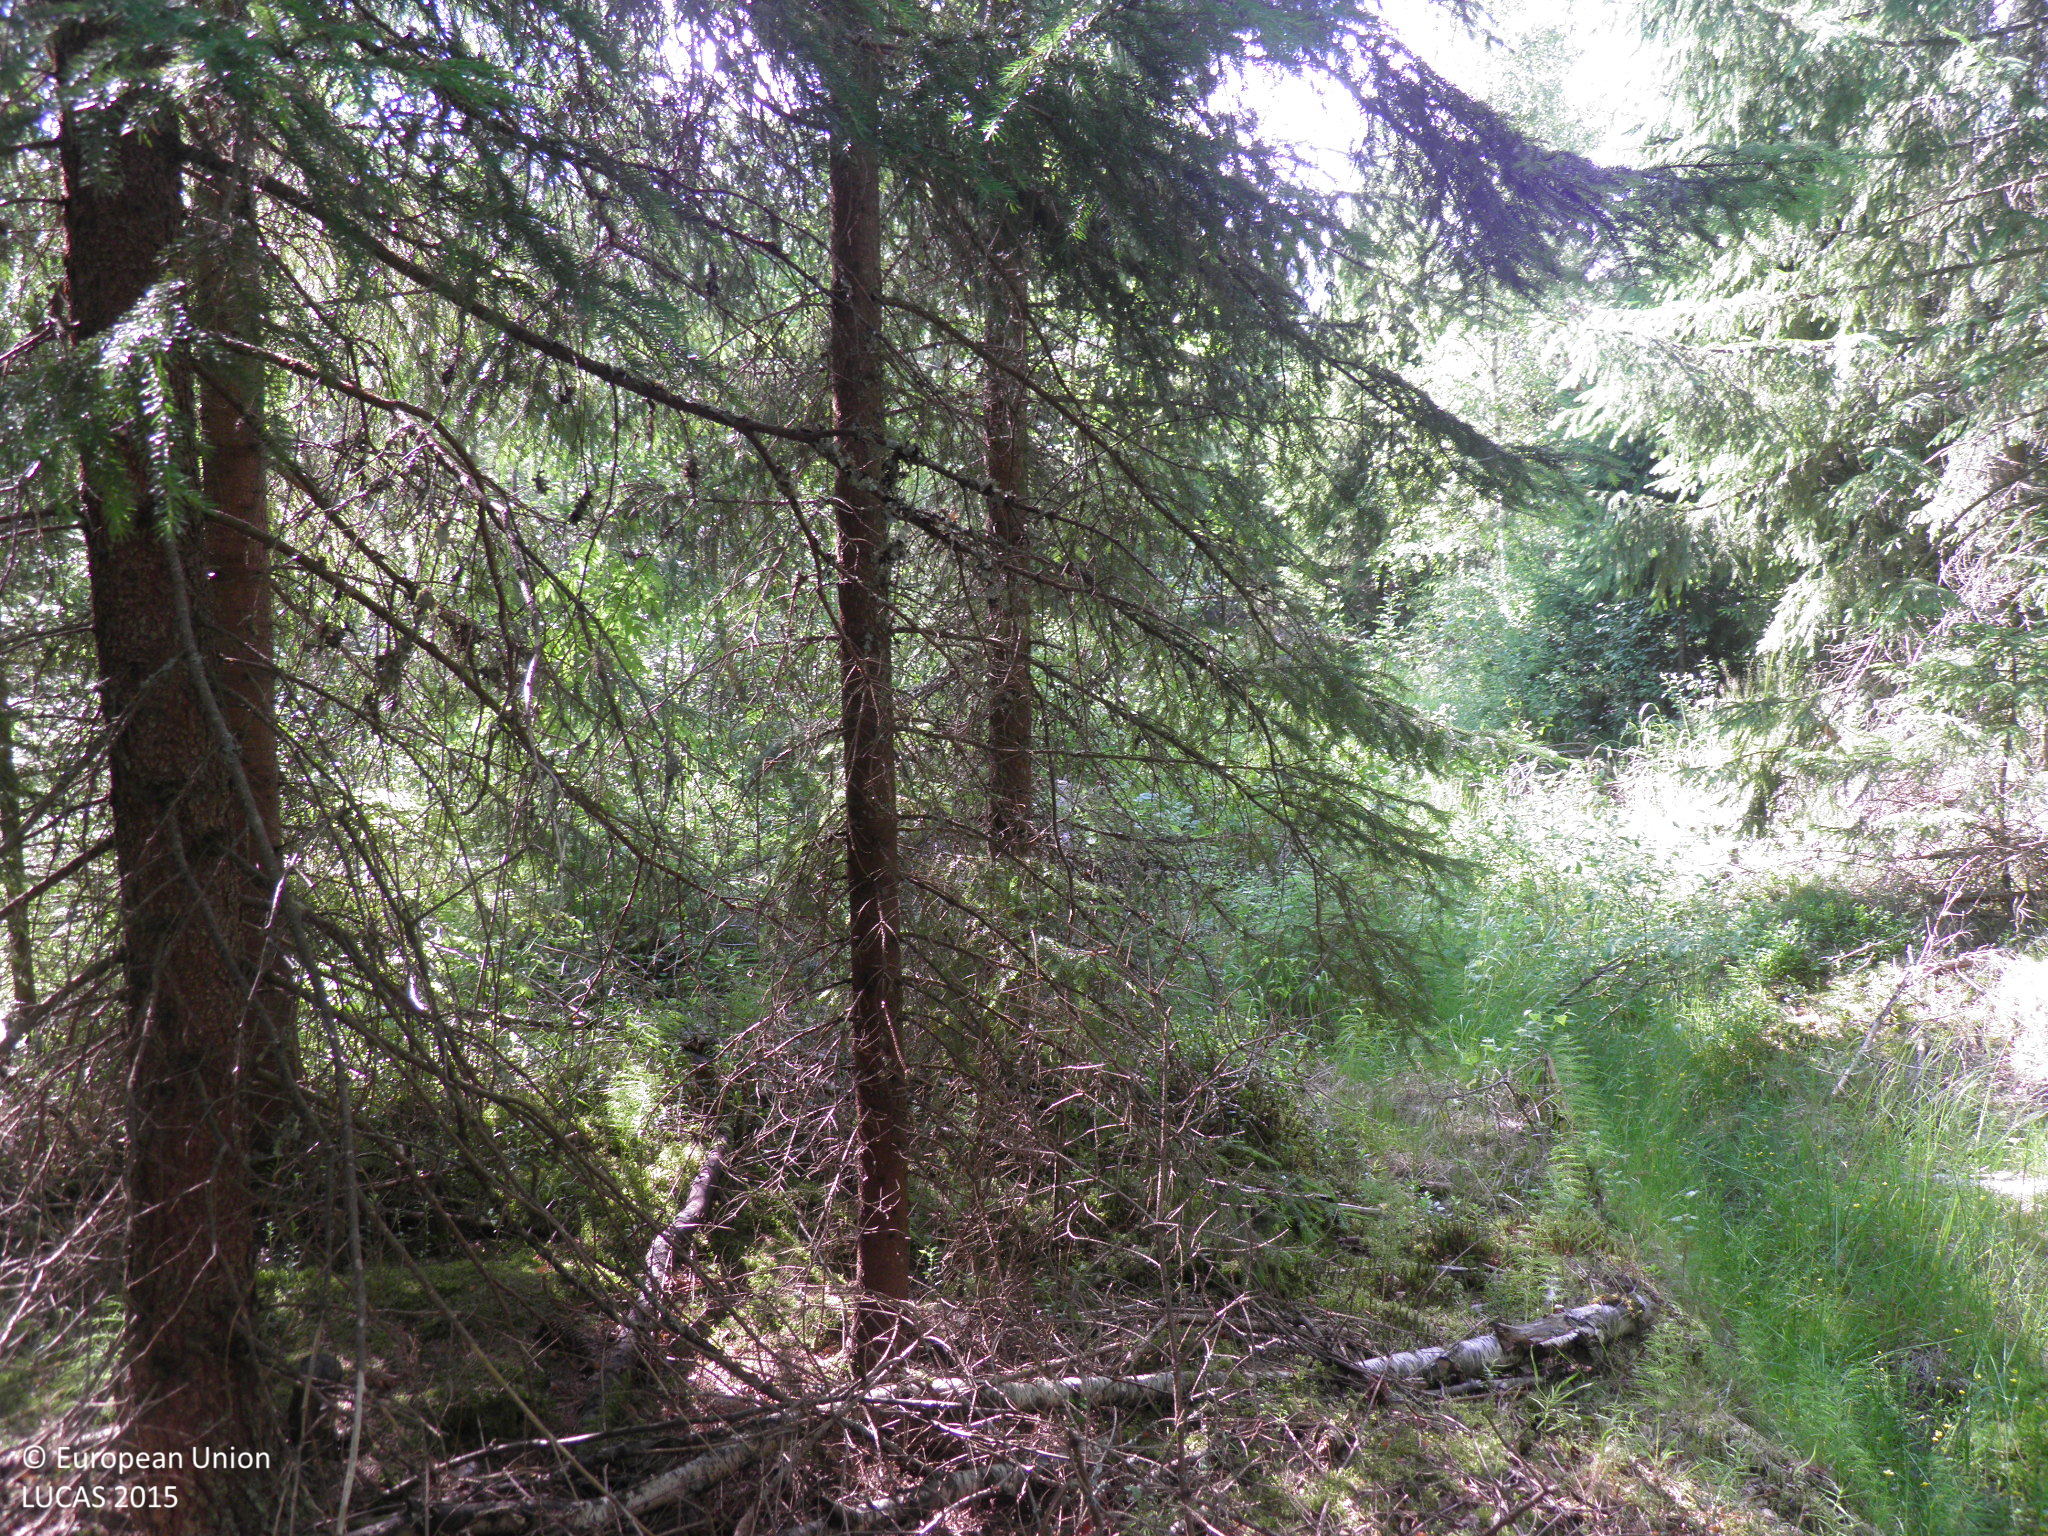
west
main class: Woodland
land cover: Spruce dominated mixed woodland
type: hemiboreal forest and nemoral coniferous forest and mixed broadleaved-coniferous forest
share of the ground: 50 - 75 %
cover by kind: coniferous forest trees 40 %, broadleaved forest trees 30 %, shrubs 10 %, herbaceous plants 10 %, lichens and mosses 10 %
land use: Forestry
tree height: > 5 m
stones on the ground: < 10 %
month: July
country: FI
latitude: 60.6250
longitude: 22.9239
